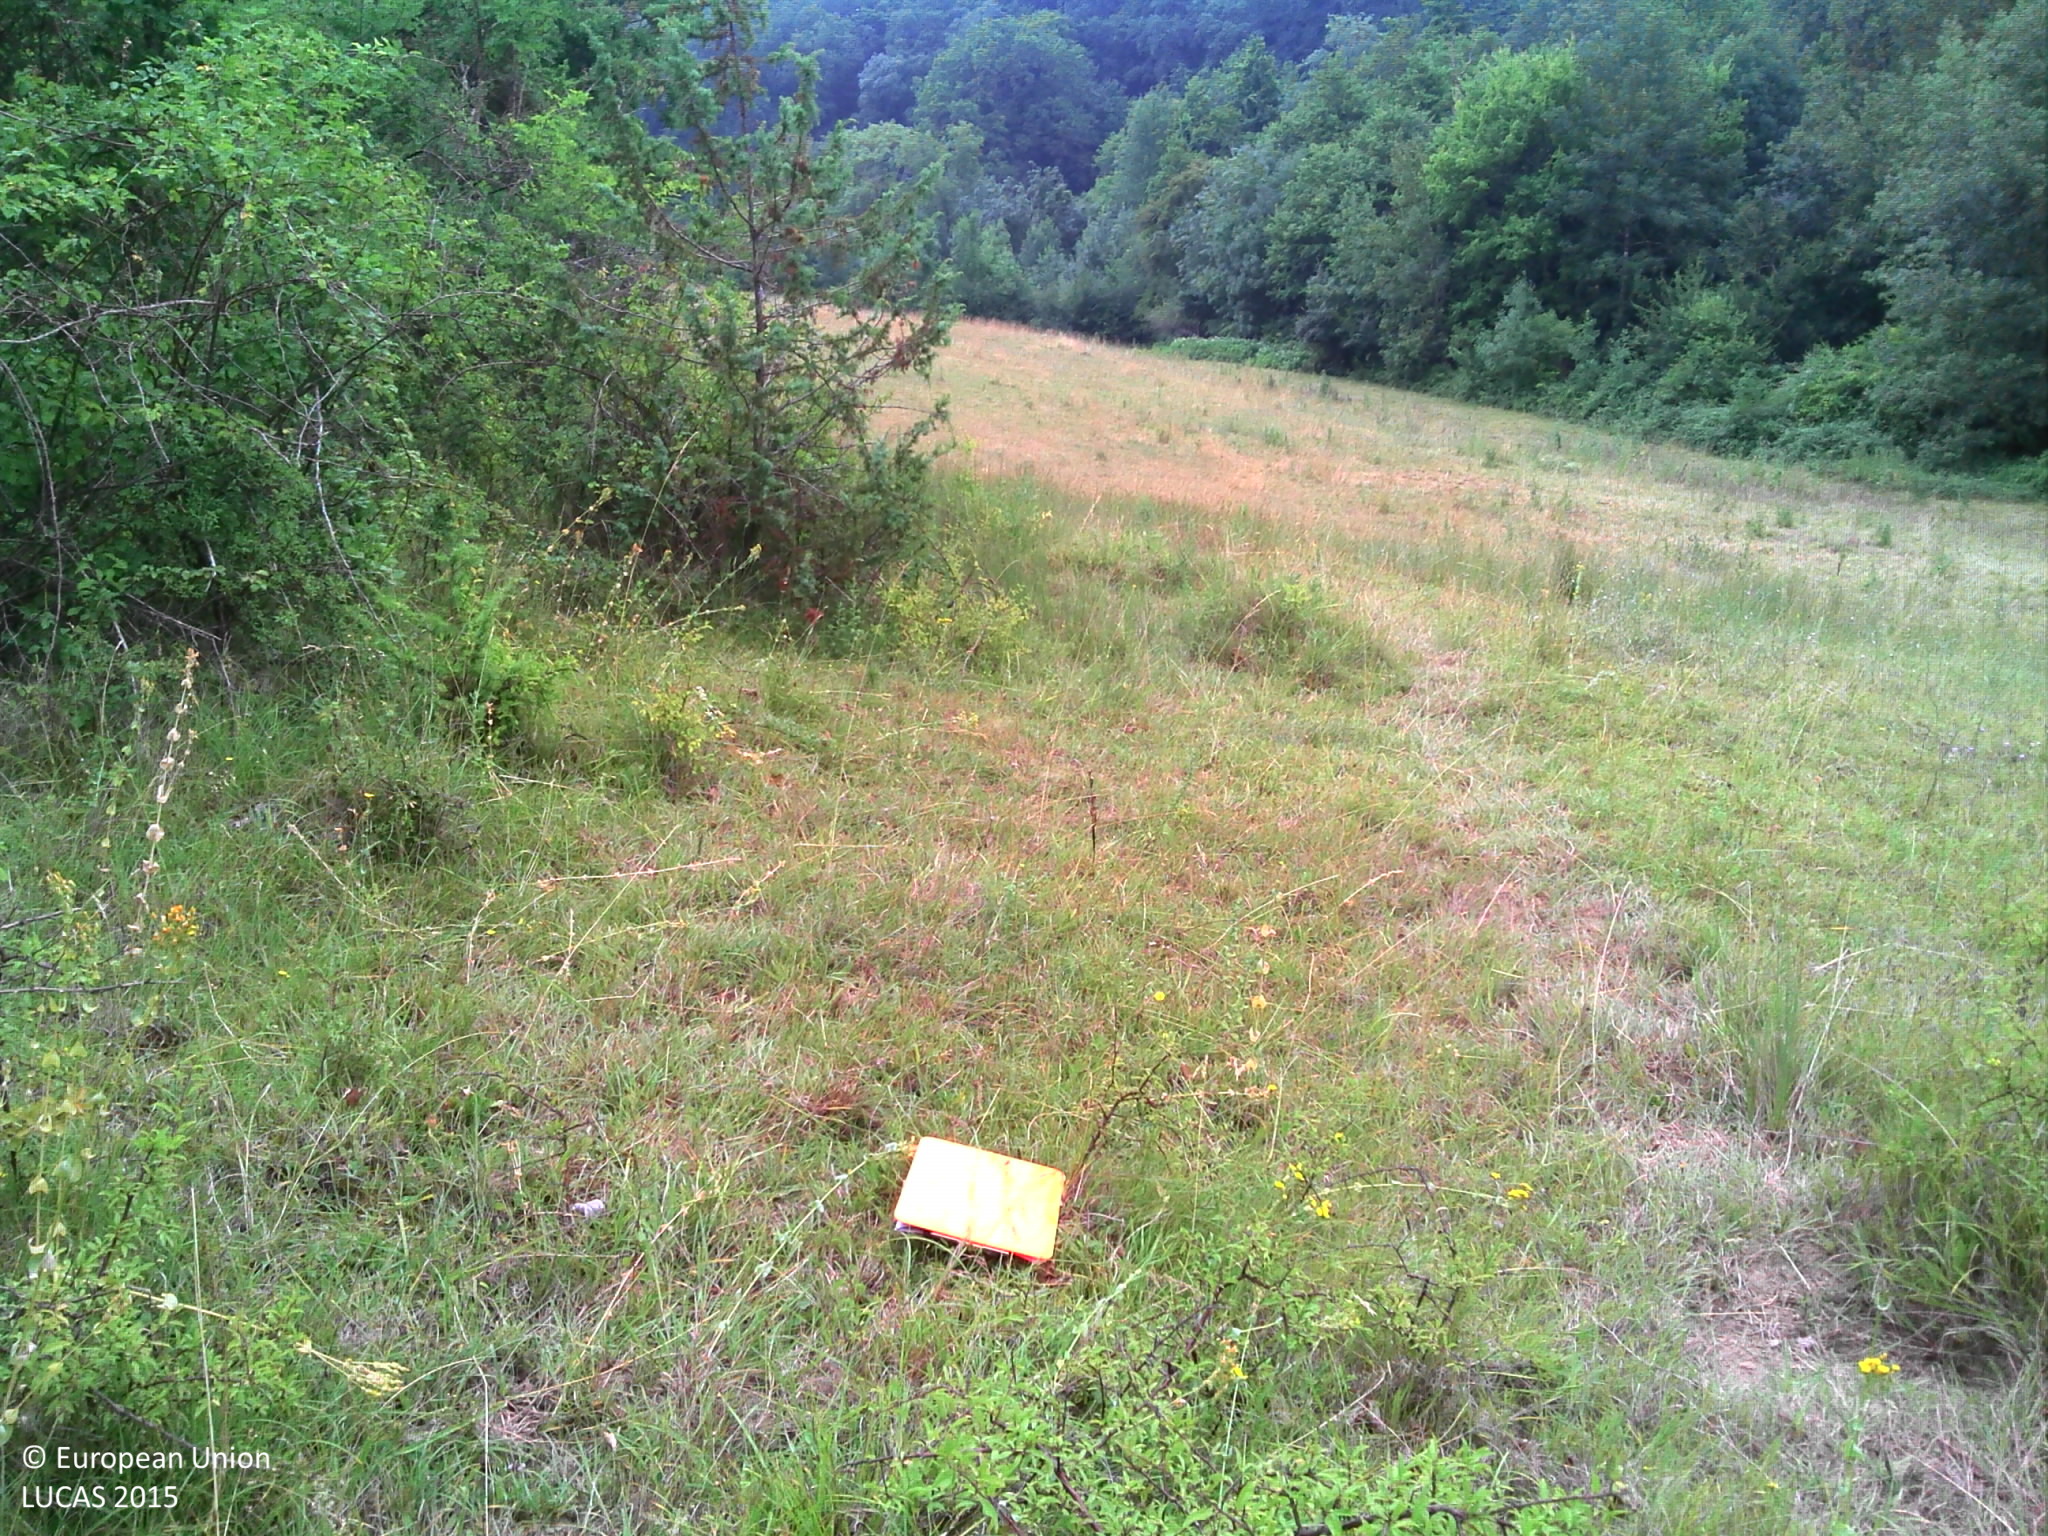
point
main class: Grassland
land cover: Grassland without tree/shrub cover
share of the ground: > 75 %
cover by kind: herbaceous plants 100 %
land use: Agriculture (excluding fallow land and kitchen gardens)
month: July
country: FR
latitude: 44.2776
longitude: 0.9122
